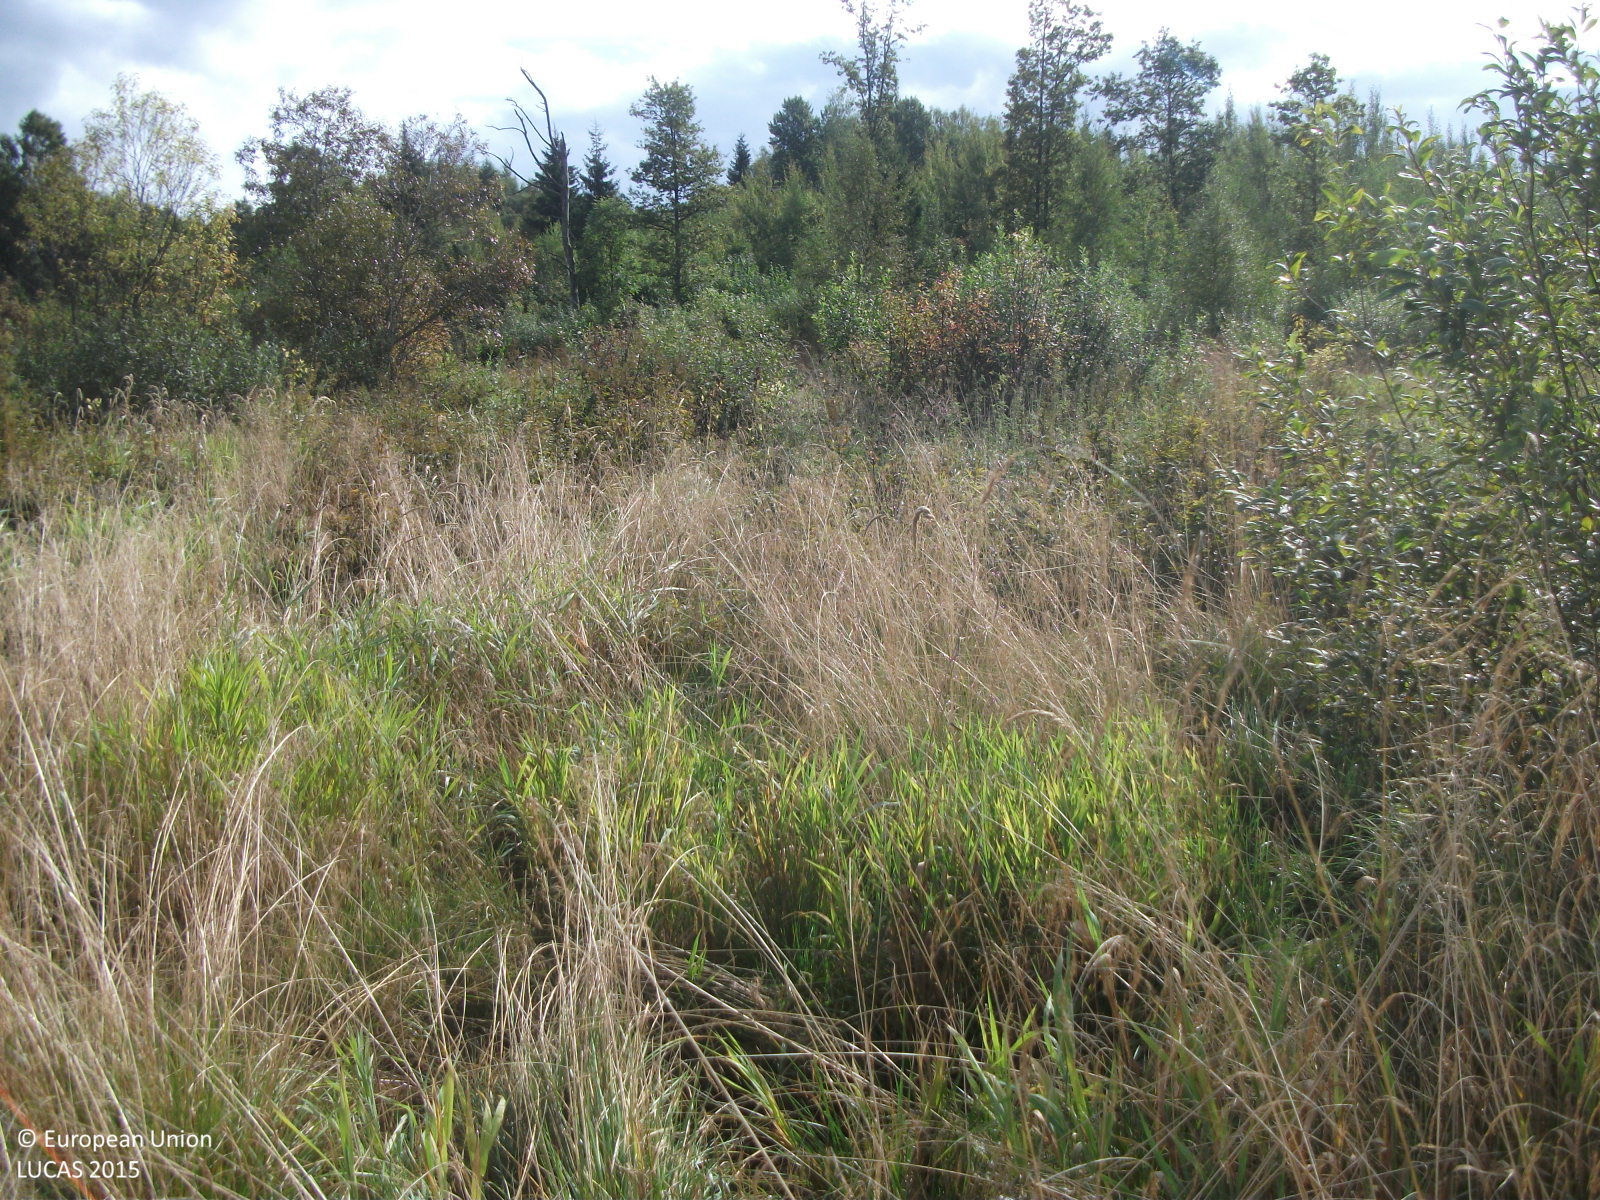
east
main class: Grassland
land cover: Spontaneously vegetated surfaces
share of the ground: > 75 %
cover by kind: herbaceous plants 95 %, shrubs 5 %
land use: Semi-natural and natural areas not in use
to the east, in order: Spontaneously vegetated surfaces; Ditches and canals; Peatbogs; Broadleaved woodland
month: September
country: LV
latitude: 57.5846
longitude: 24.7310
